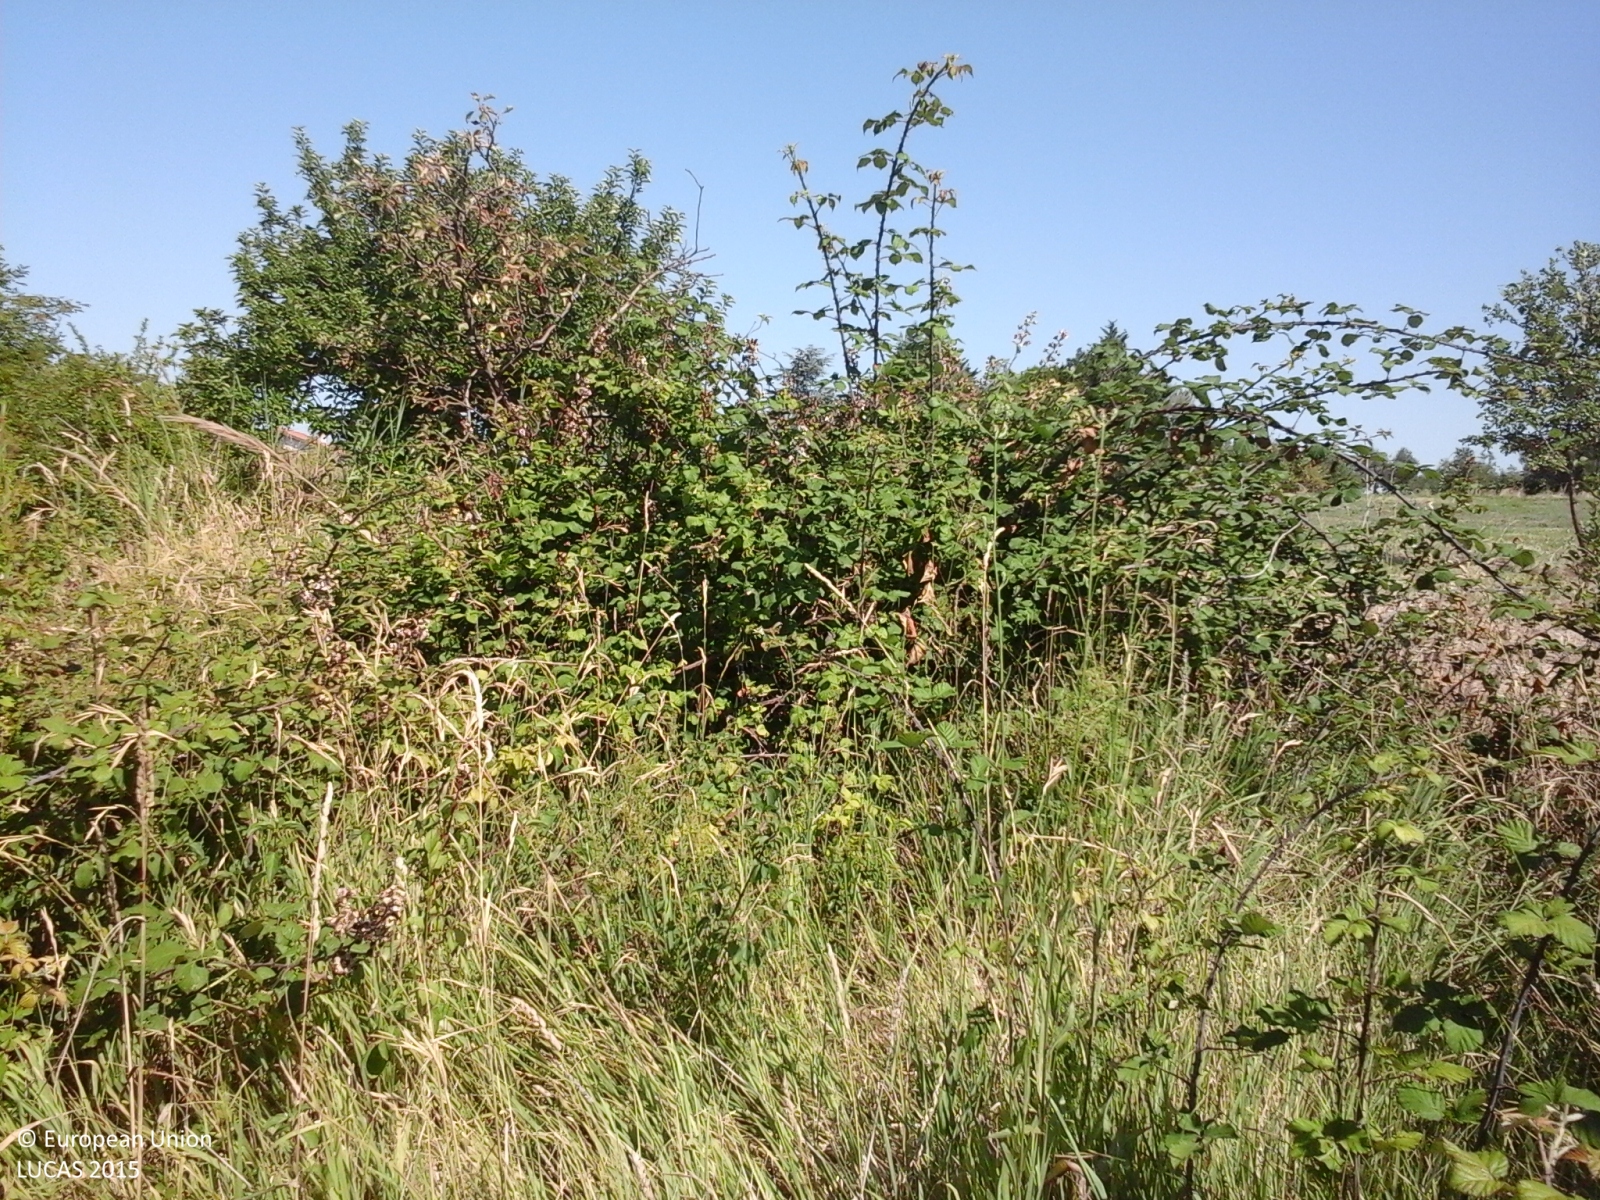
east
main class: Shrubland
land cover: Shrubland with sparse tree cover
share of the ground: > 75 %
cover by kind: shrubs 90 %, broadleaved forest trees 5 %, herbaceous plants 5 %
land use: Semi-natural and natural areas not in use
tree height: < 5 m
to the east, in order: Shrubland with sparse tree cover; Tracks; Abandoned hedges; Fences; Other fruit trees and berries; Olive groves; Other fresh vegetables; Olive groves; Tracks; Olive groves; Tomatoes; Other fresh vegetables; Tracks; Managed hedges; Fences; Olive groves; Conifer hedges
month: July
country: IT
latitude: 42.3608
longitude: 14.3702
